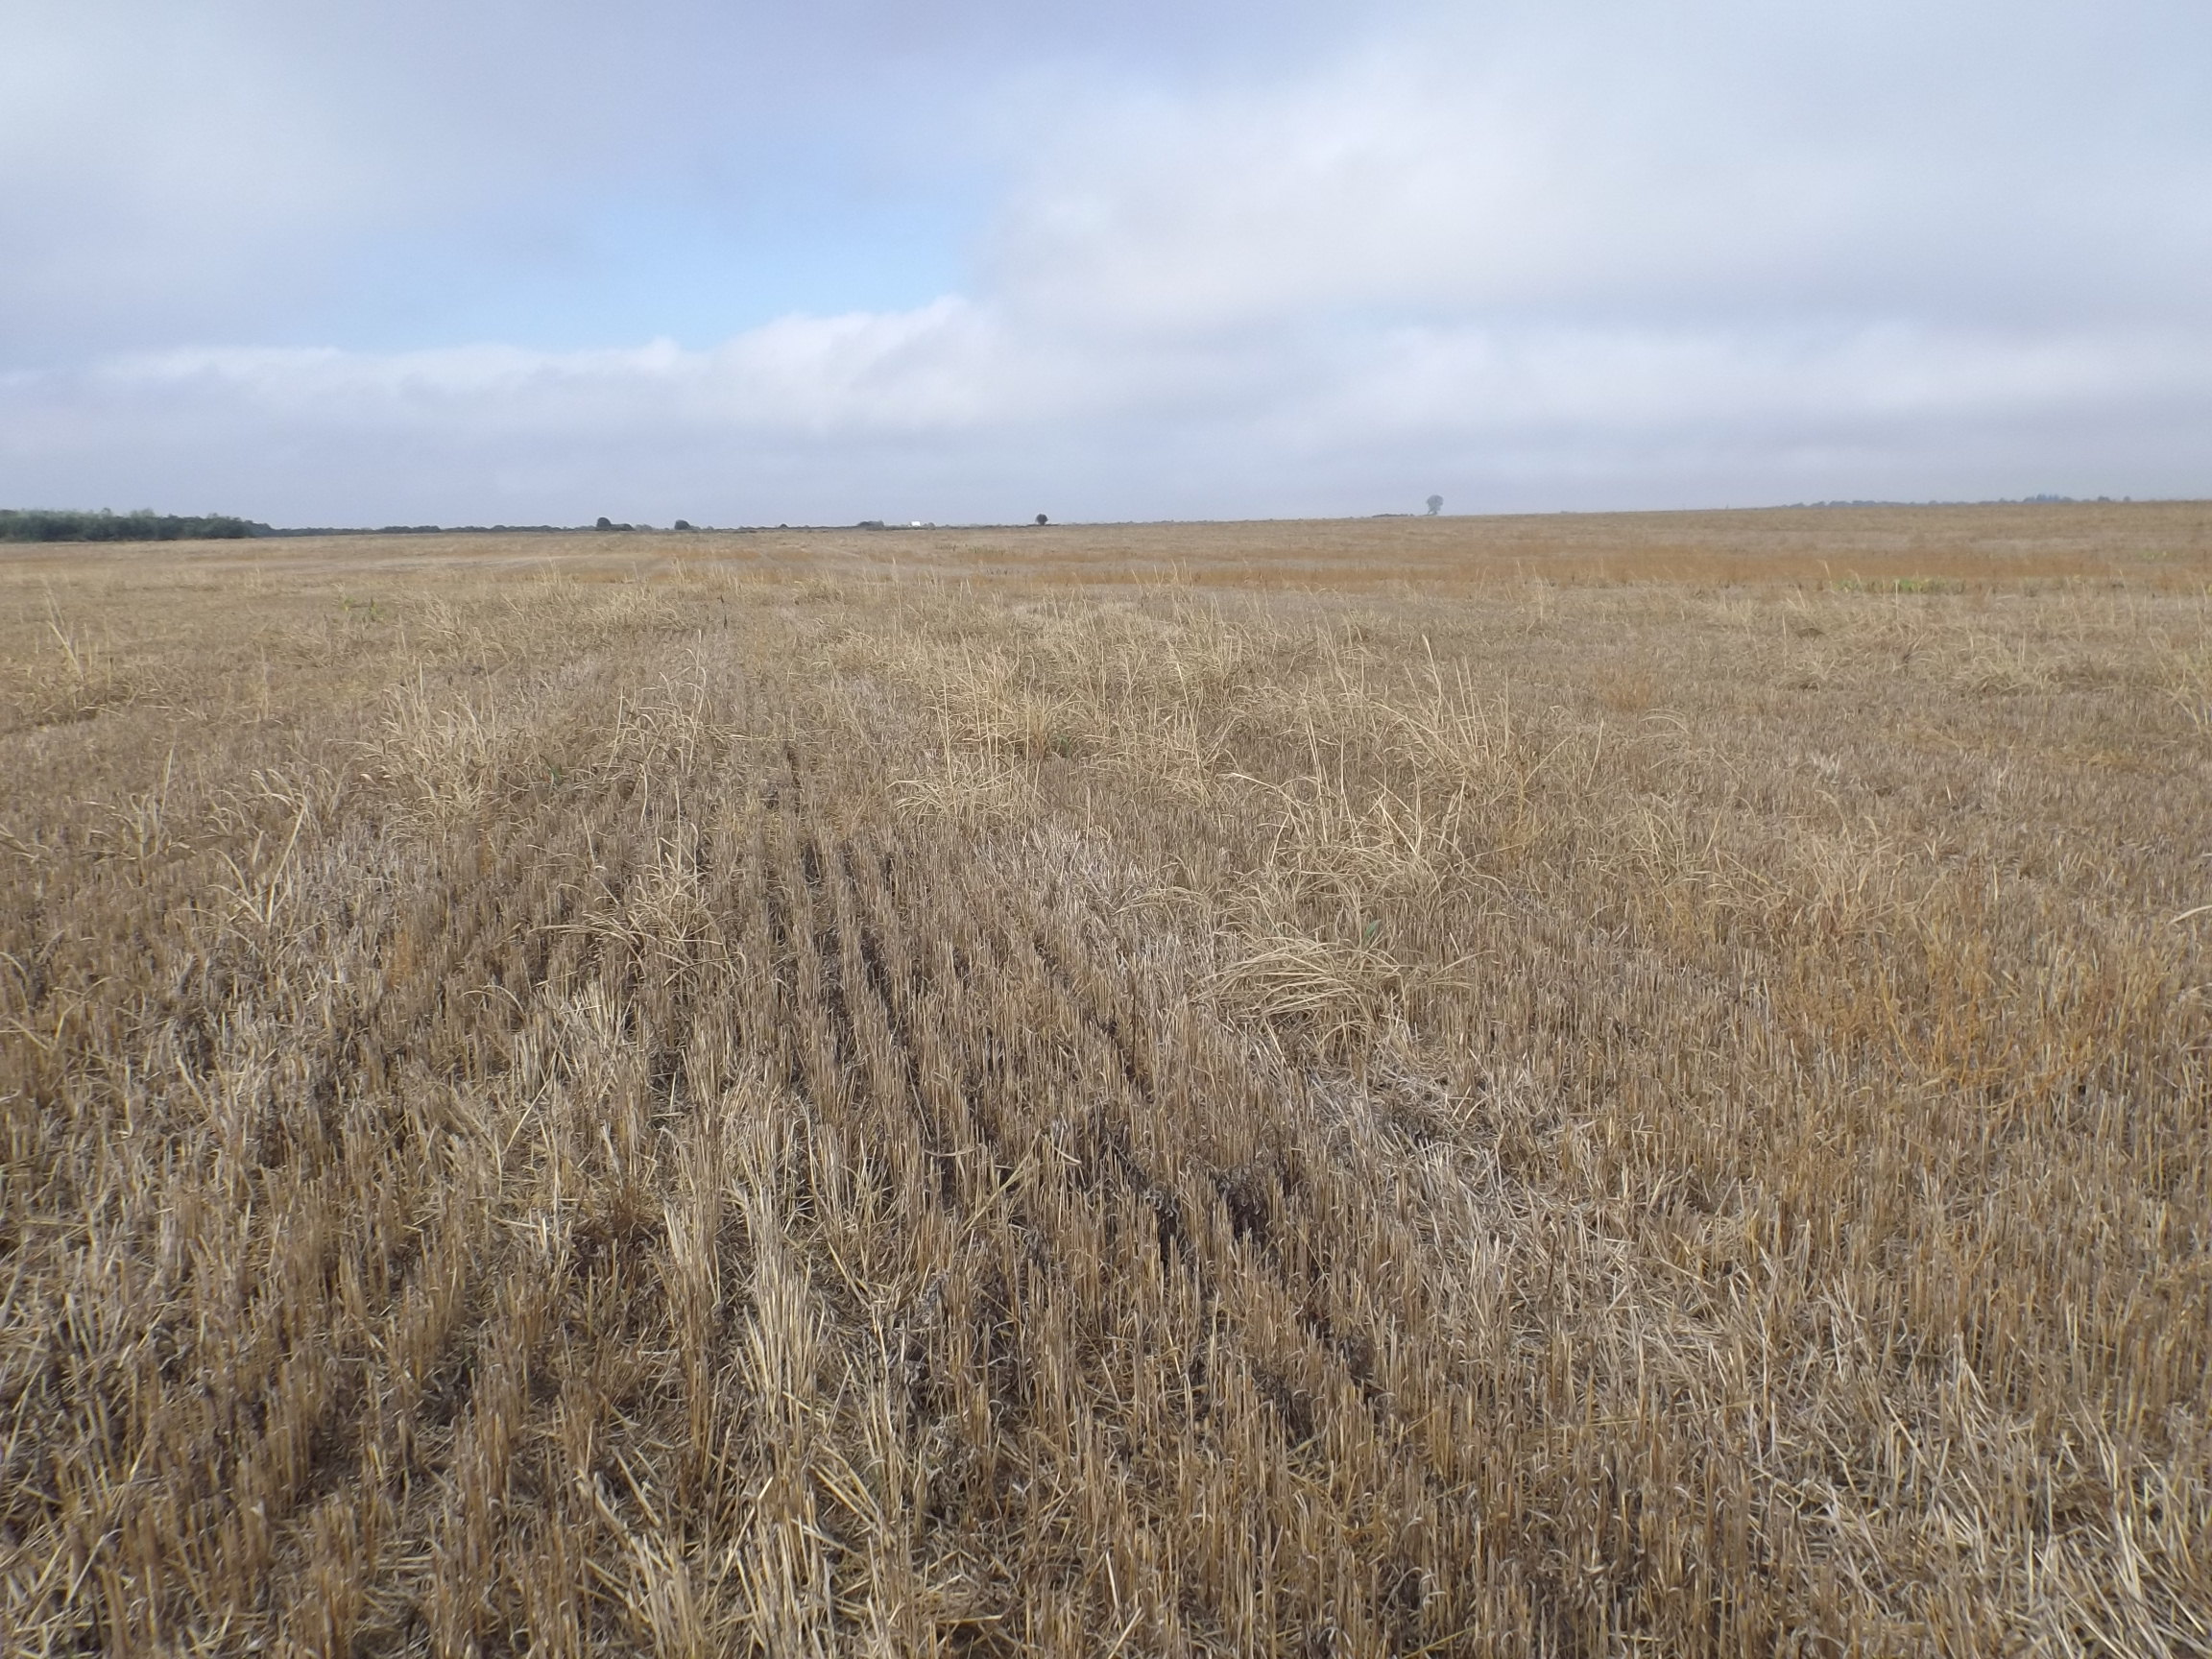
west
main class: Cropland
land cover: Oats
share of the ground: 50 - 75 %
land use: Agriculture (excluding fallow land and kitchen gardens)
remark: Harvested field
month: September
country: BG
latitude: 43.9762
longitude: 26.3749
